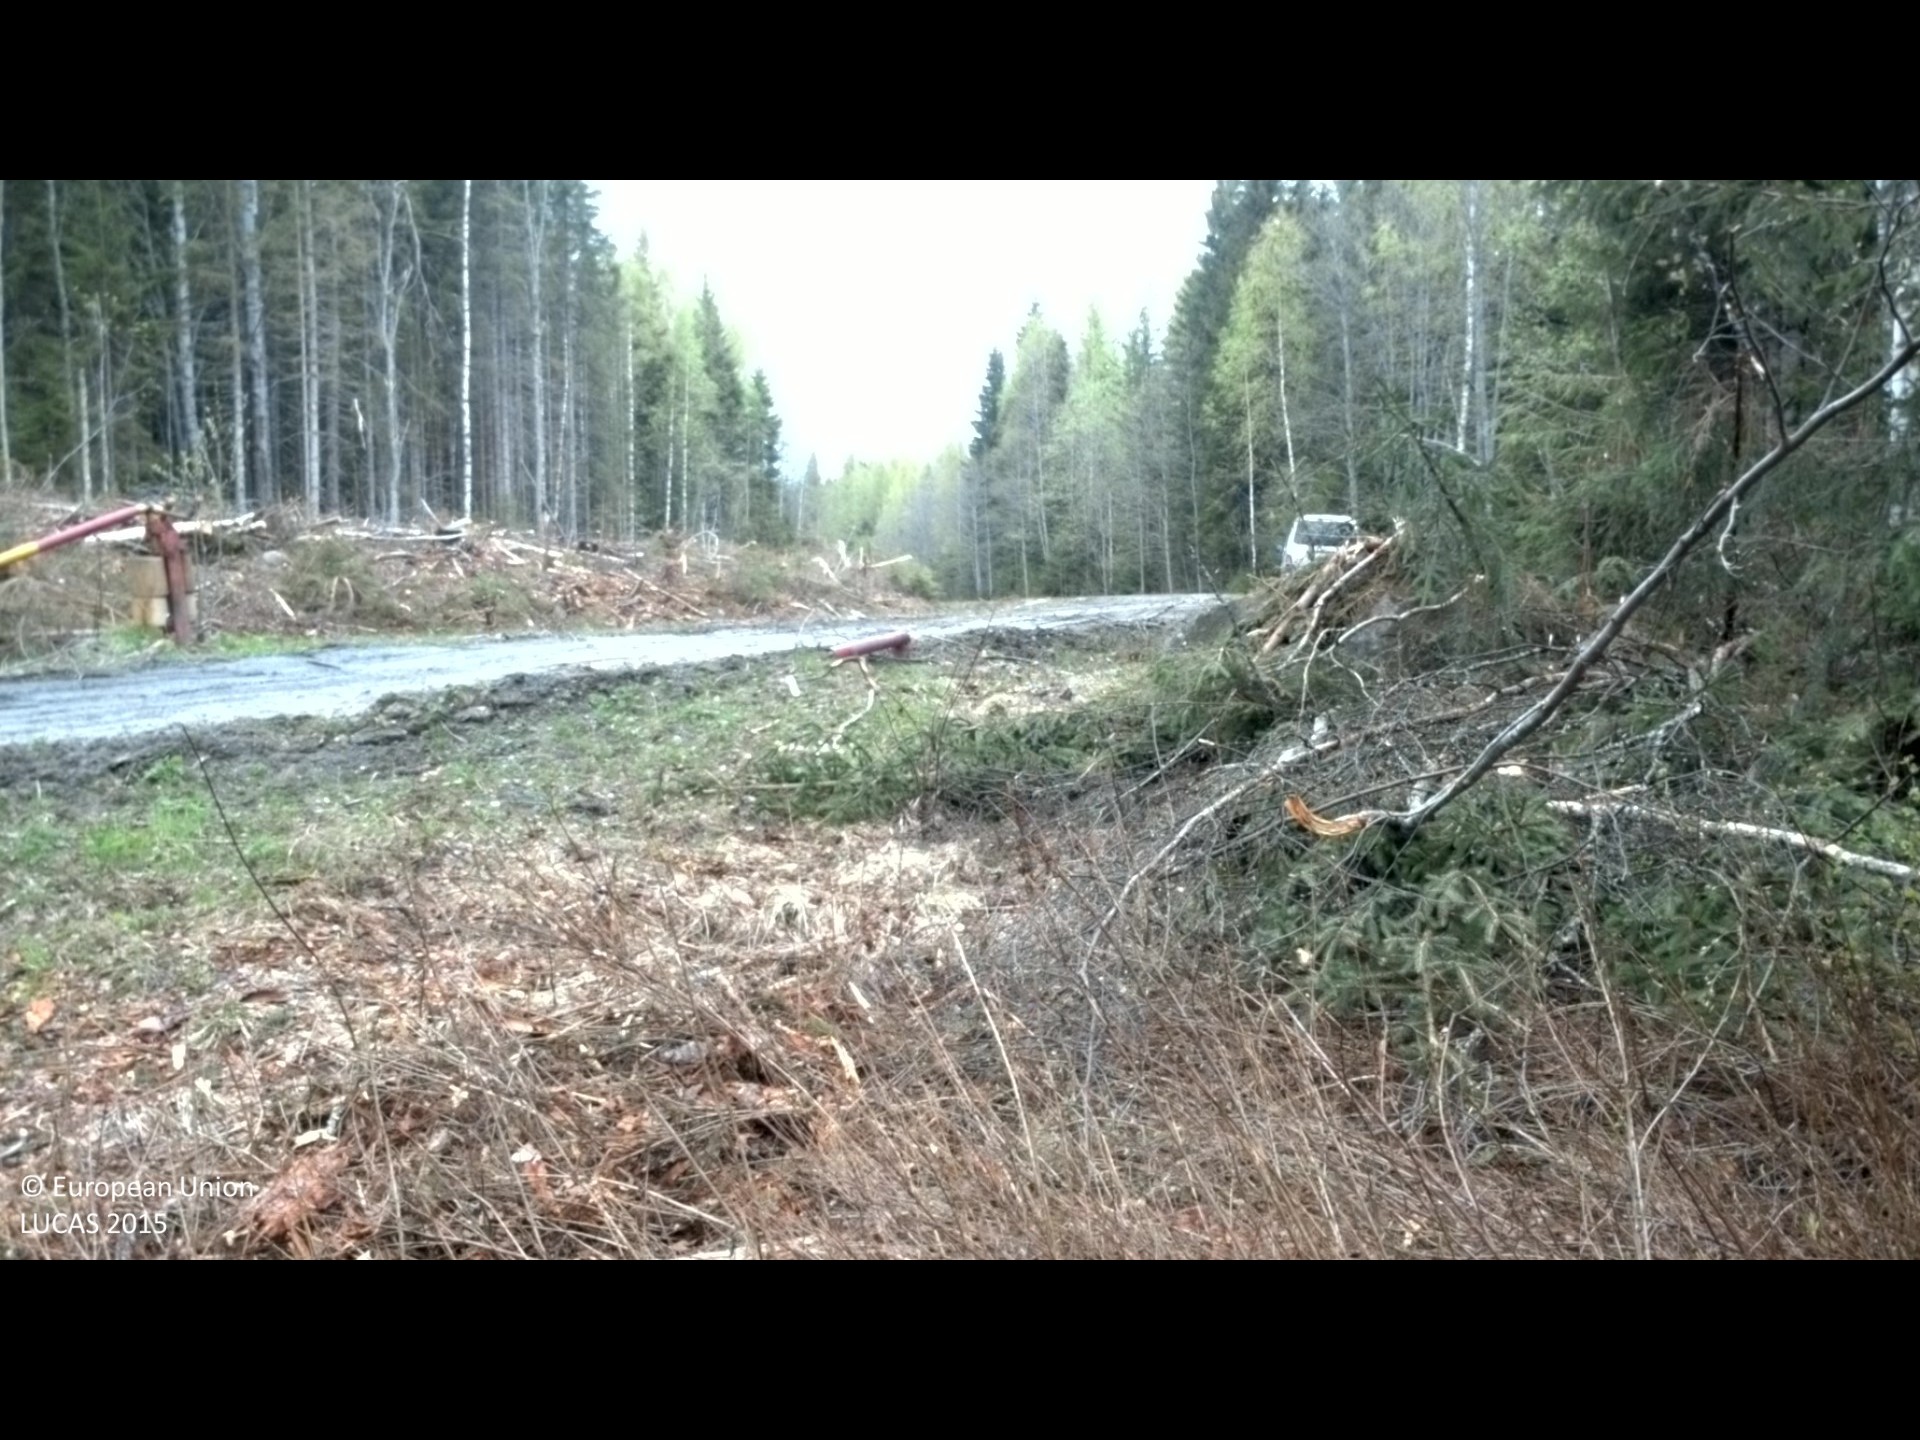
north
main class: Shrubland
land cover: Shrubland with sparse tree cover
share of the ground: > 75 %
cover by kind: shrubs 95 %, broadleaved forest trees 5 %
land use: Abandoned areas
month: May
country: SE
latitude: 63.1044
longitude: 17.3274
